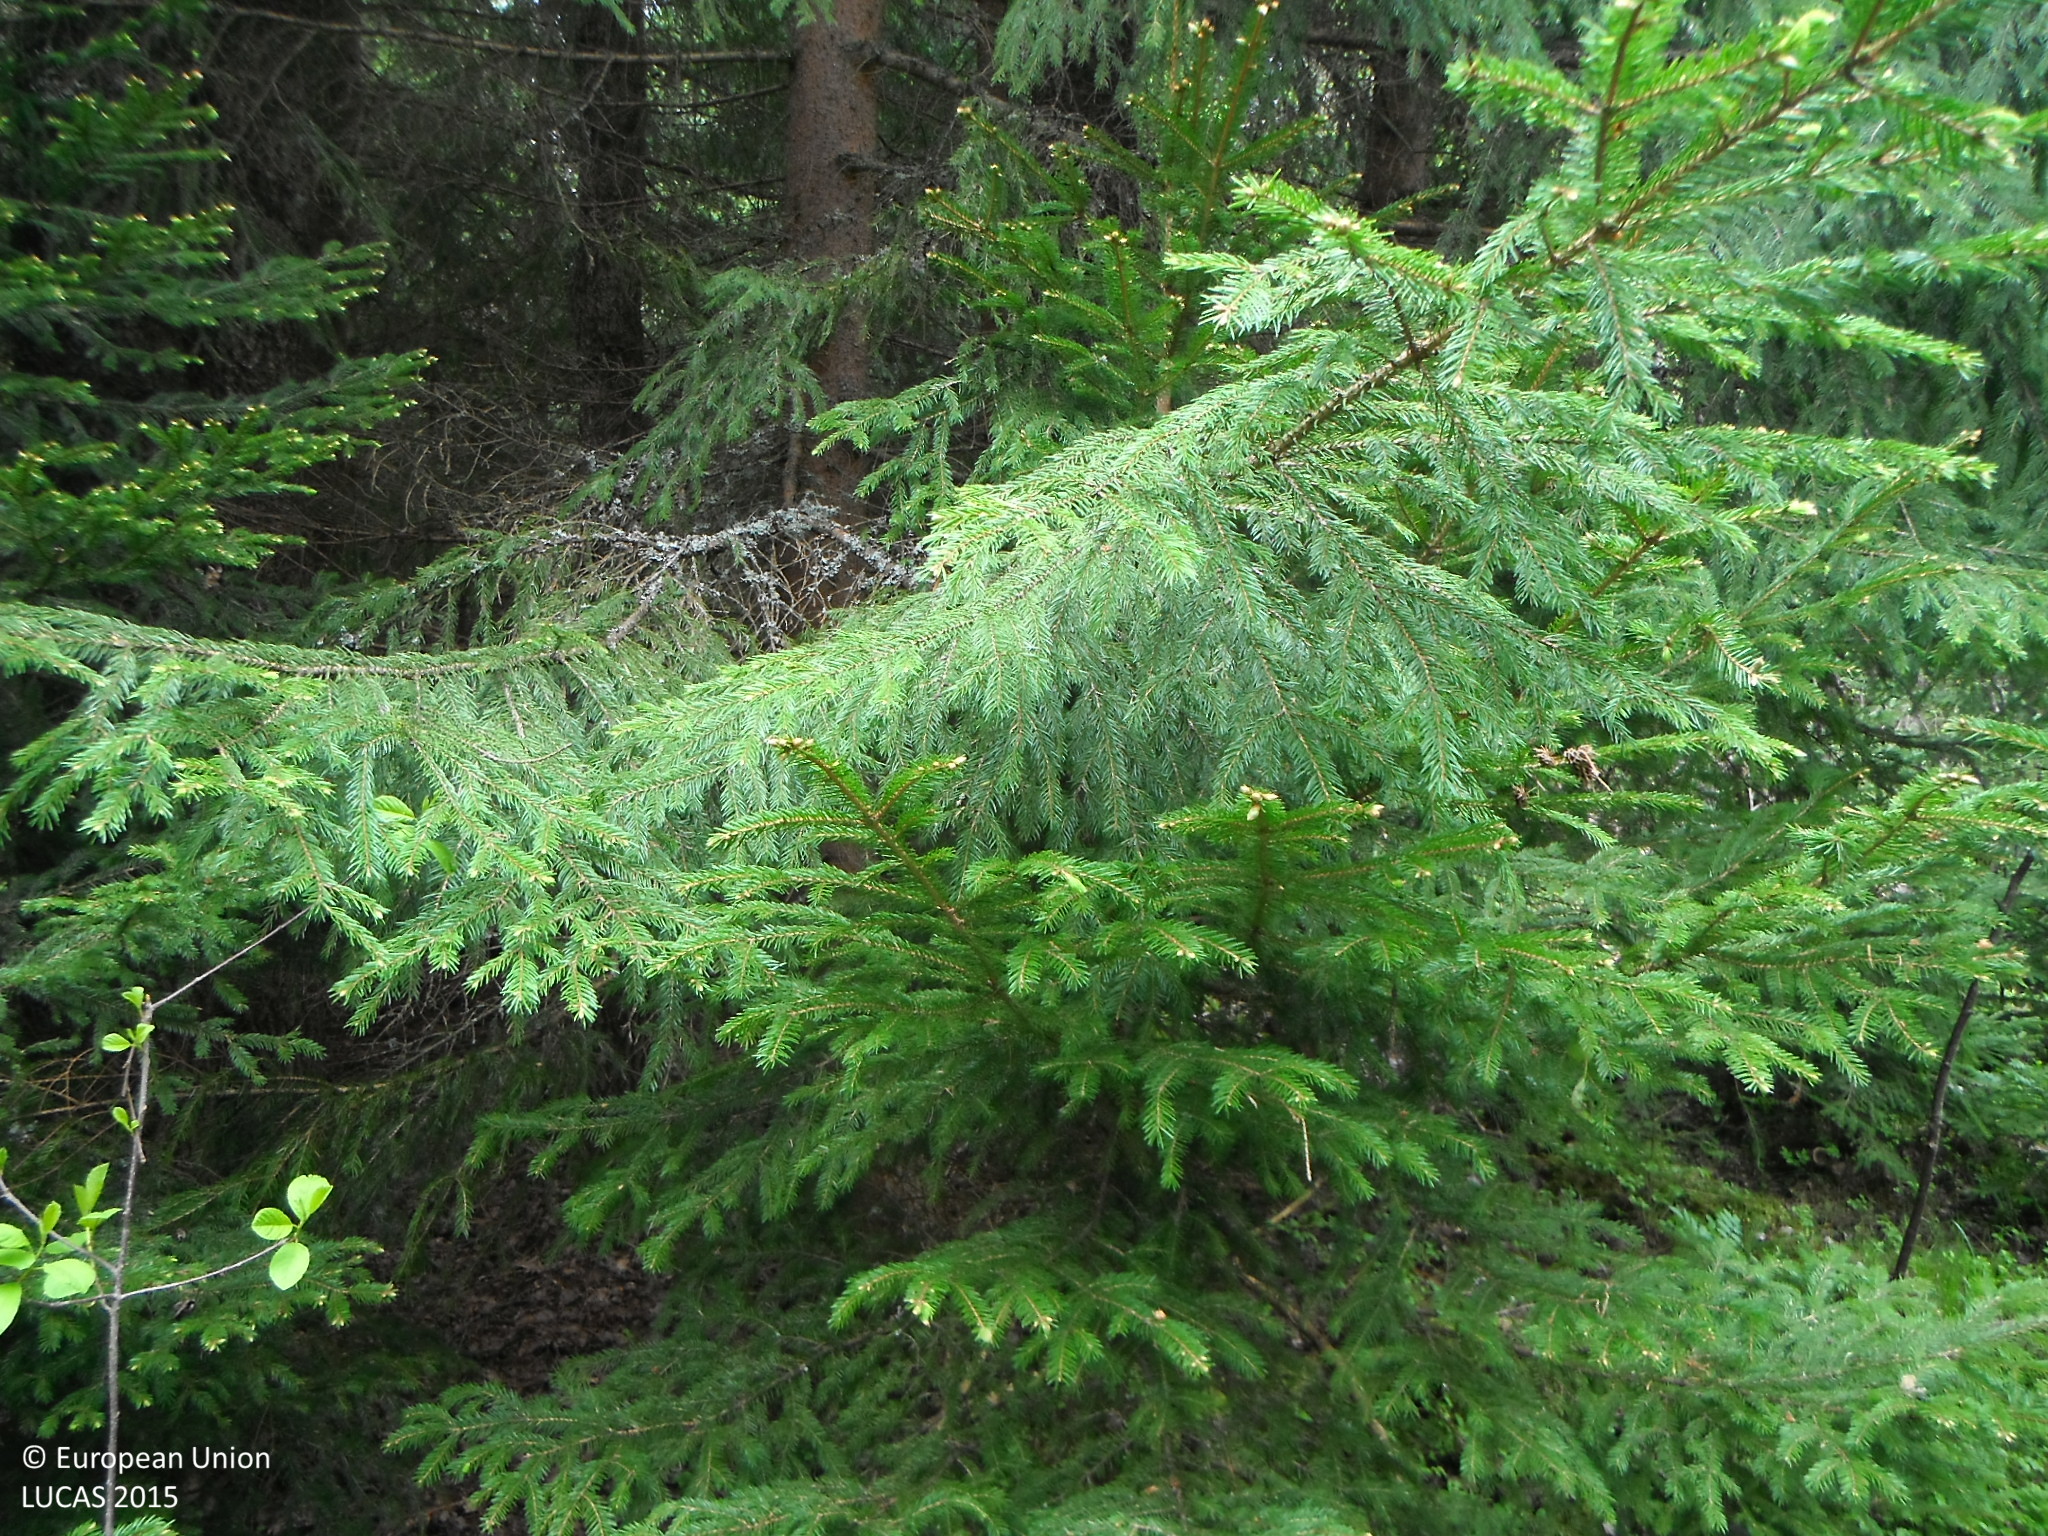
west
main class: Woodland
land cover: Spruce dominated coniferous woodland
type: alpine coniferous forest
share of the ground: > 75 %
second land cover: Spontaneously vegetated surfaces
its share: 25 - 50 %
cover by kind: coniferous forest trees 75 %, herbaceous plants 25 %
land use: Forestry
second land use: Agriculture (excluding fallow land and kitchen gardens)
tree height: > 5 m
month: June
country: SK
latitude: 49.1116
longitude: 19.7690
